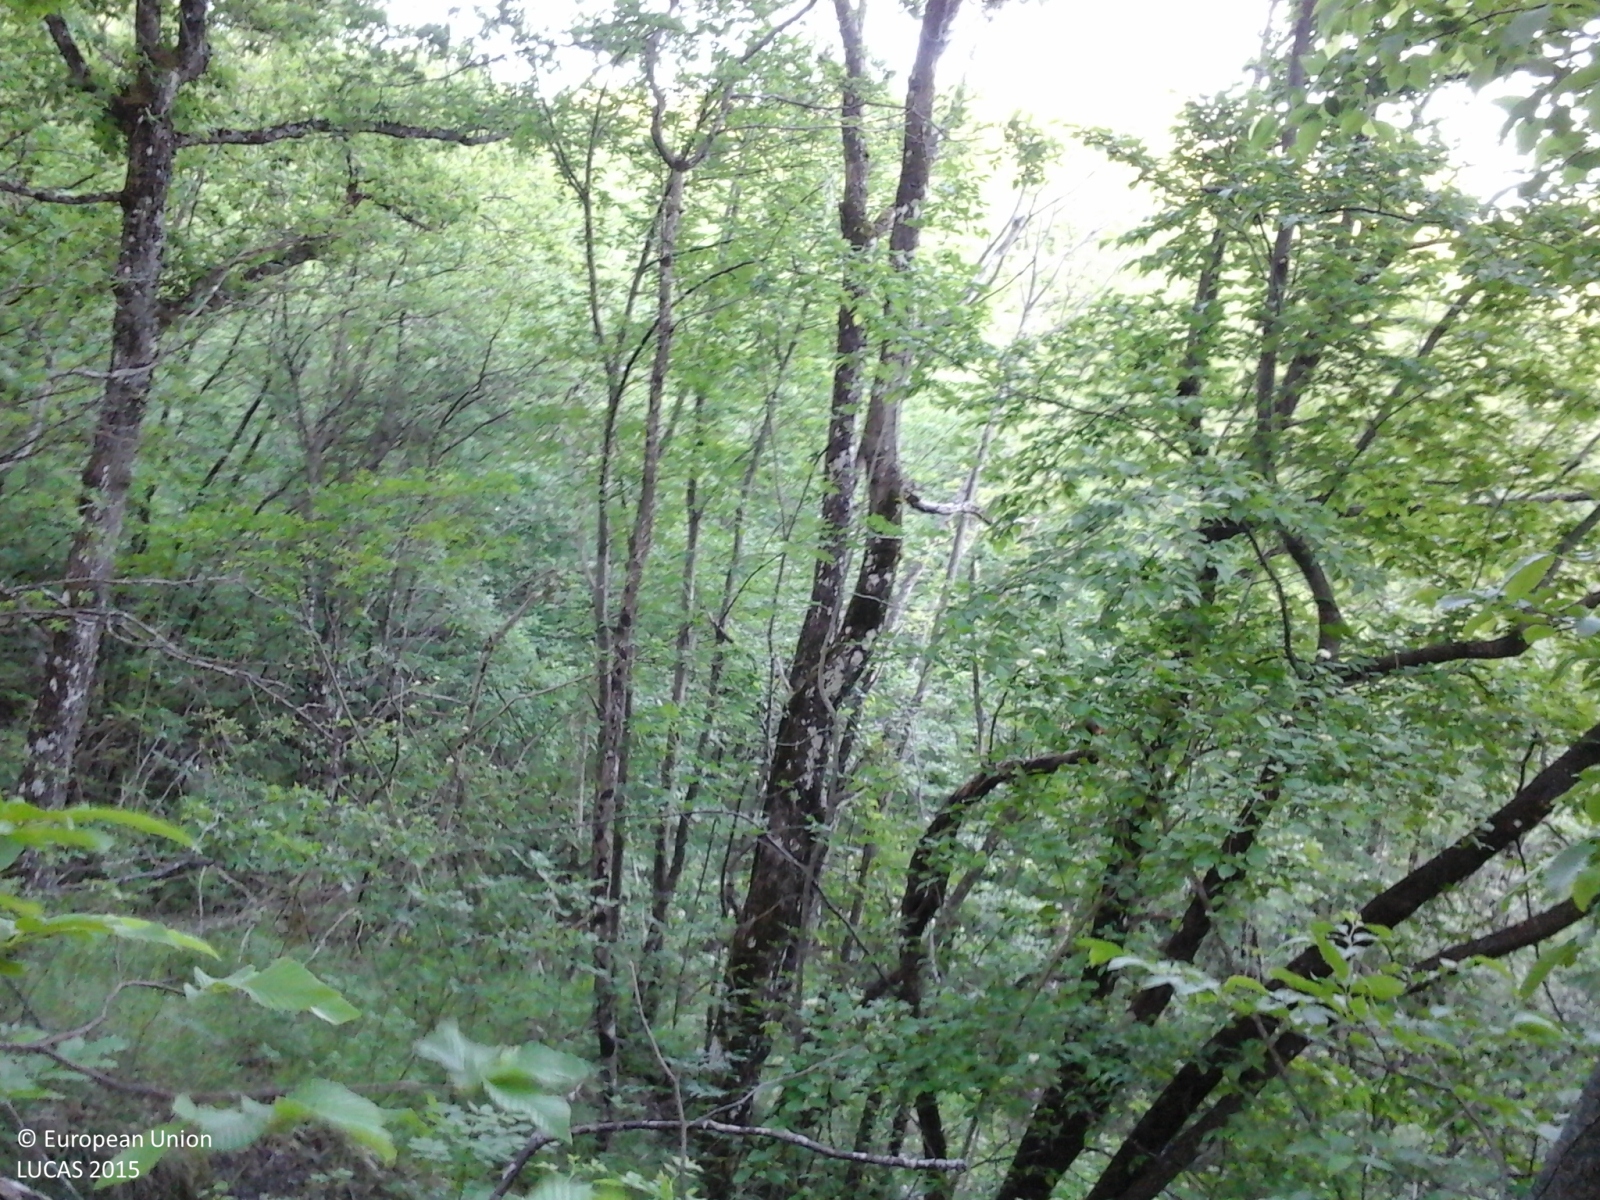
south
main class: Woodland
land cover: Broadleaved woodland
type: thermophilous deciduous forest
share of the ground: > 75 %
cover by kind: broadleaved forest trees 100 %
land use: Forestry
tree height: > 5 m
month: May
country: IT
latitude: 44.5309
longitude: 9.9121
